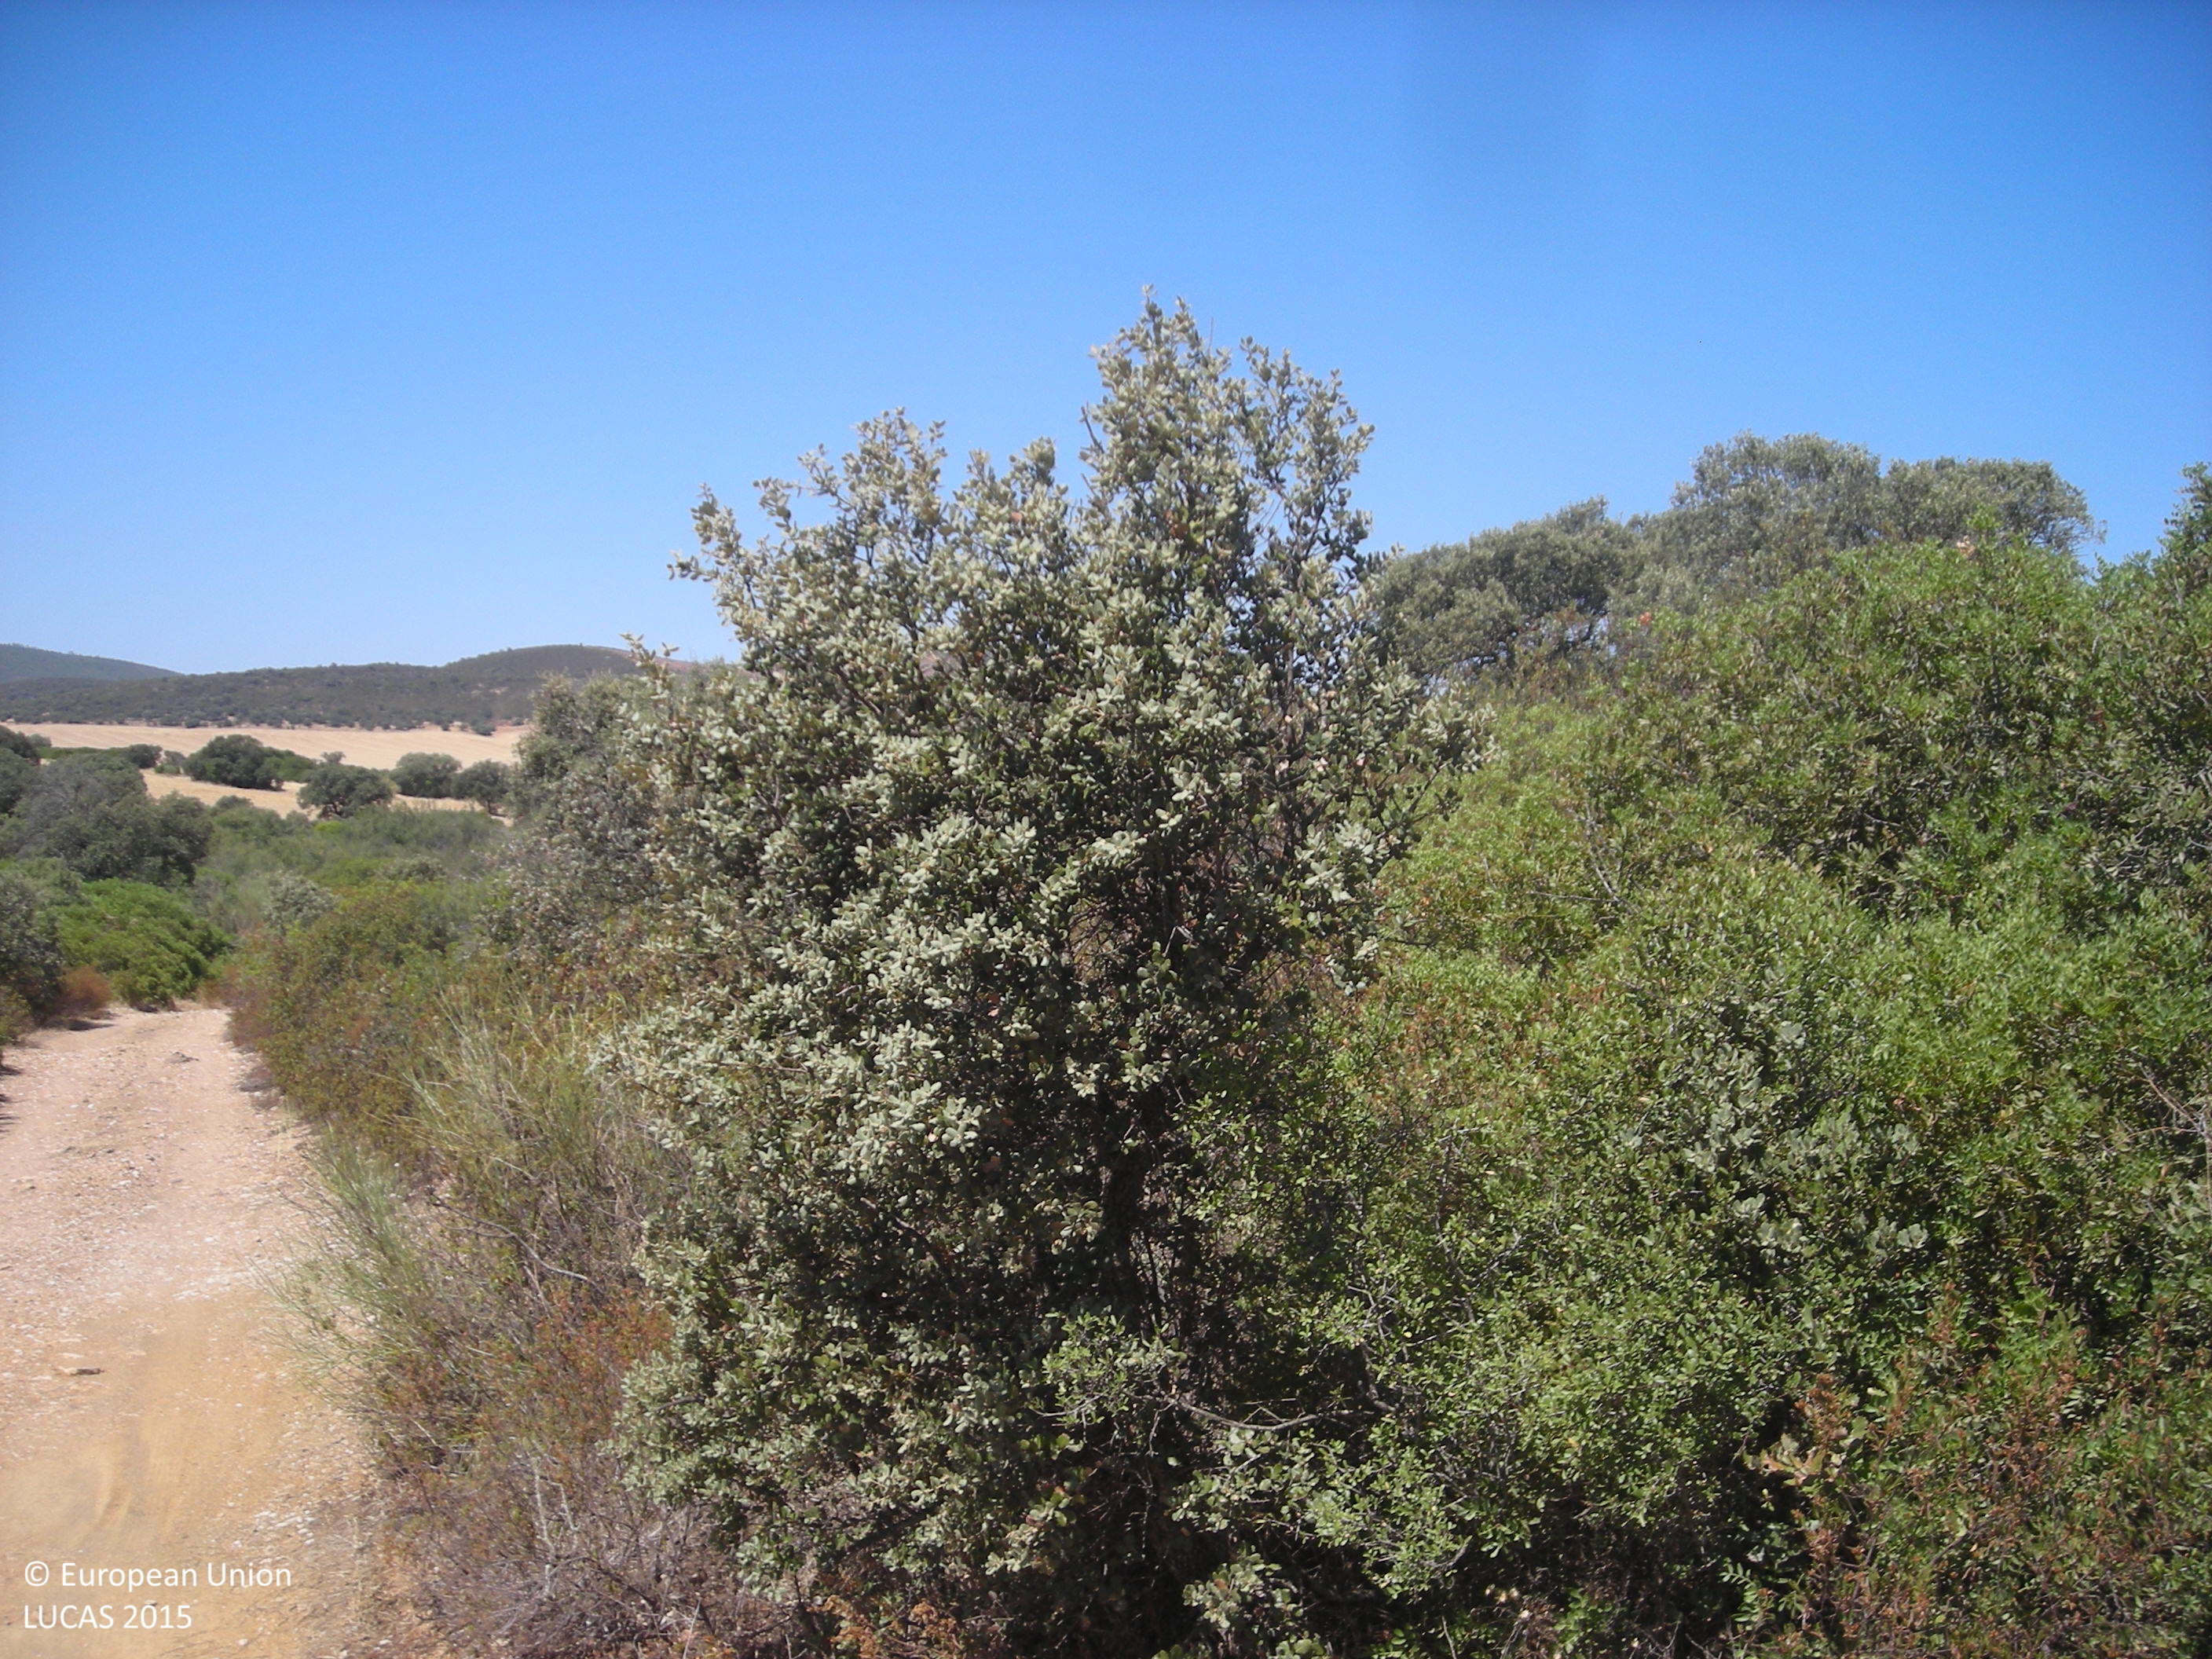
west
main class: Grassland
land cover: Grassland without tree/shrub cover
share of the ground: > 75 %
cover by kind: herbaceous plants 100 %
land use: Agriculture (excluding fallow land and kitchen gardens)
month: July
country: ES
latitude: 38.7740
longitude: -5.9198
